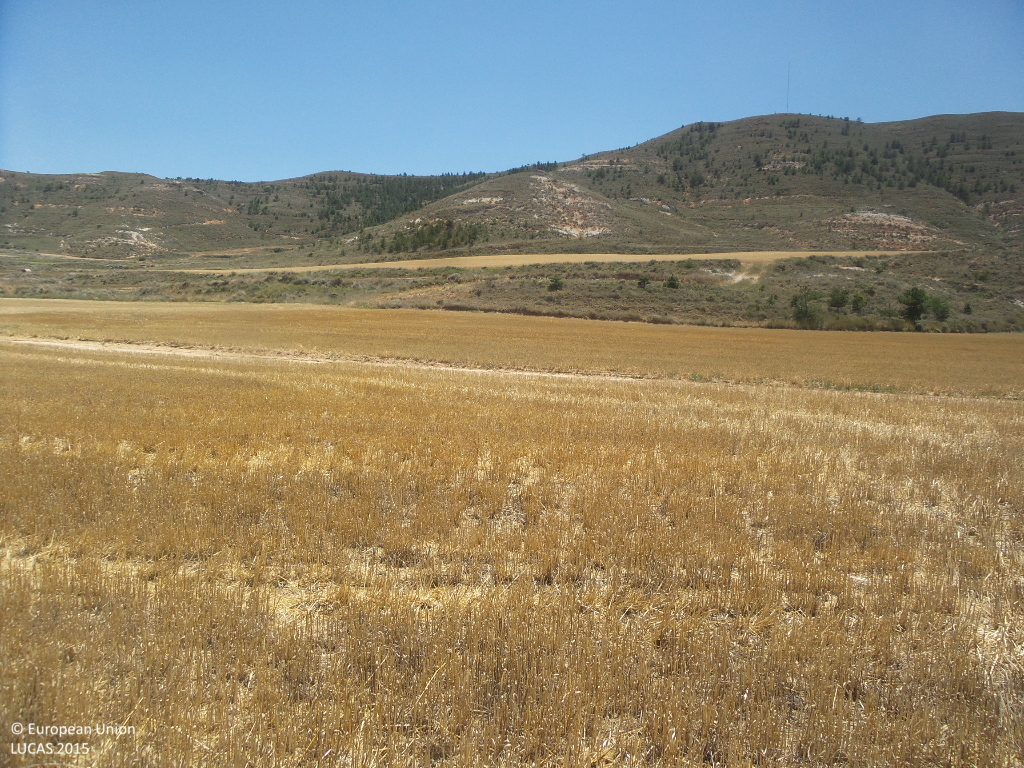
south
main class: Cropland
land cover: Barley
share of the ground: < 10 %
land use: Agriculture (excluding fallow land and kitchen gardens)
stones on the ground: < 10 %
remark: Harvested field
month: July
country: ES
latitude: 41.4325
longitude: -2.1053
